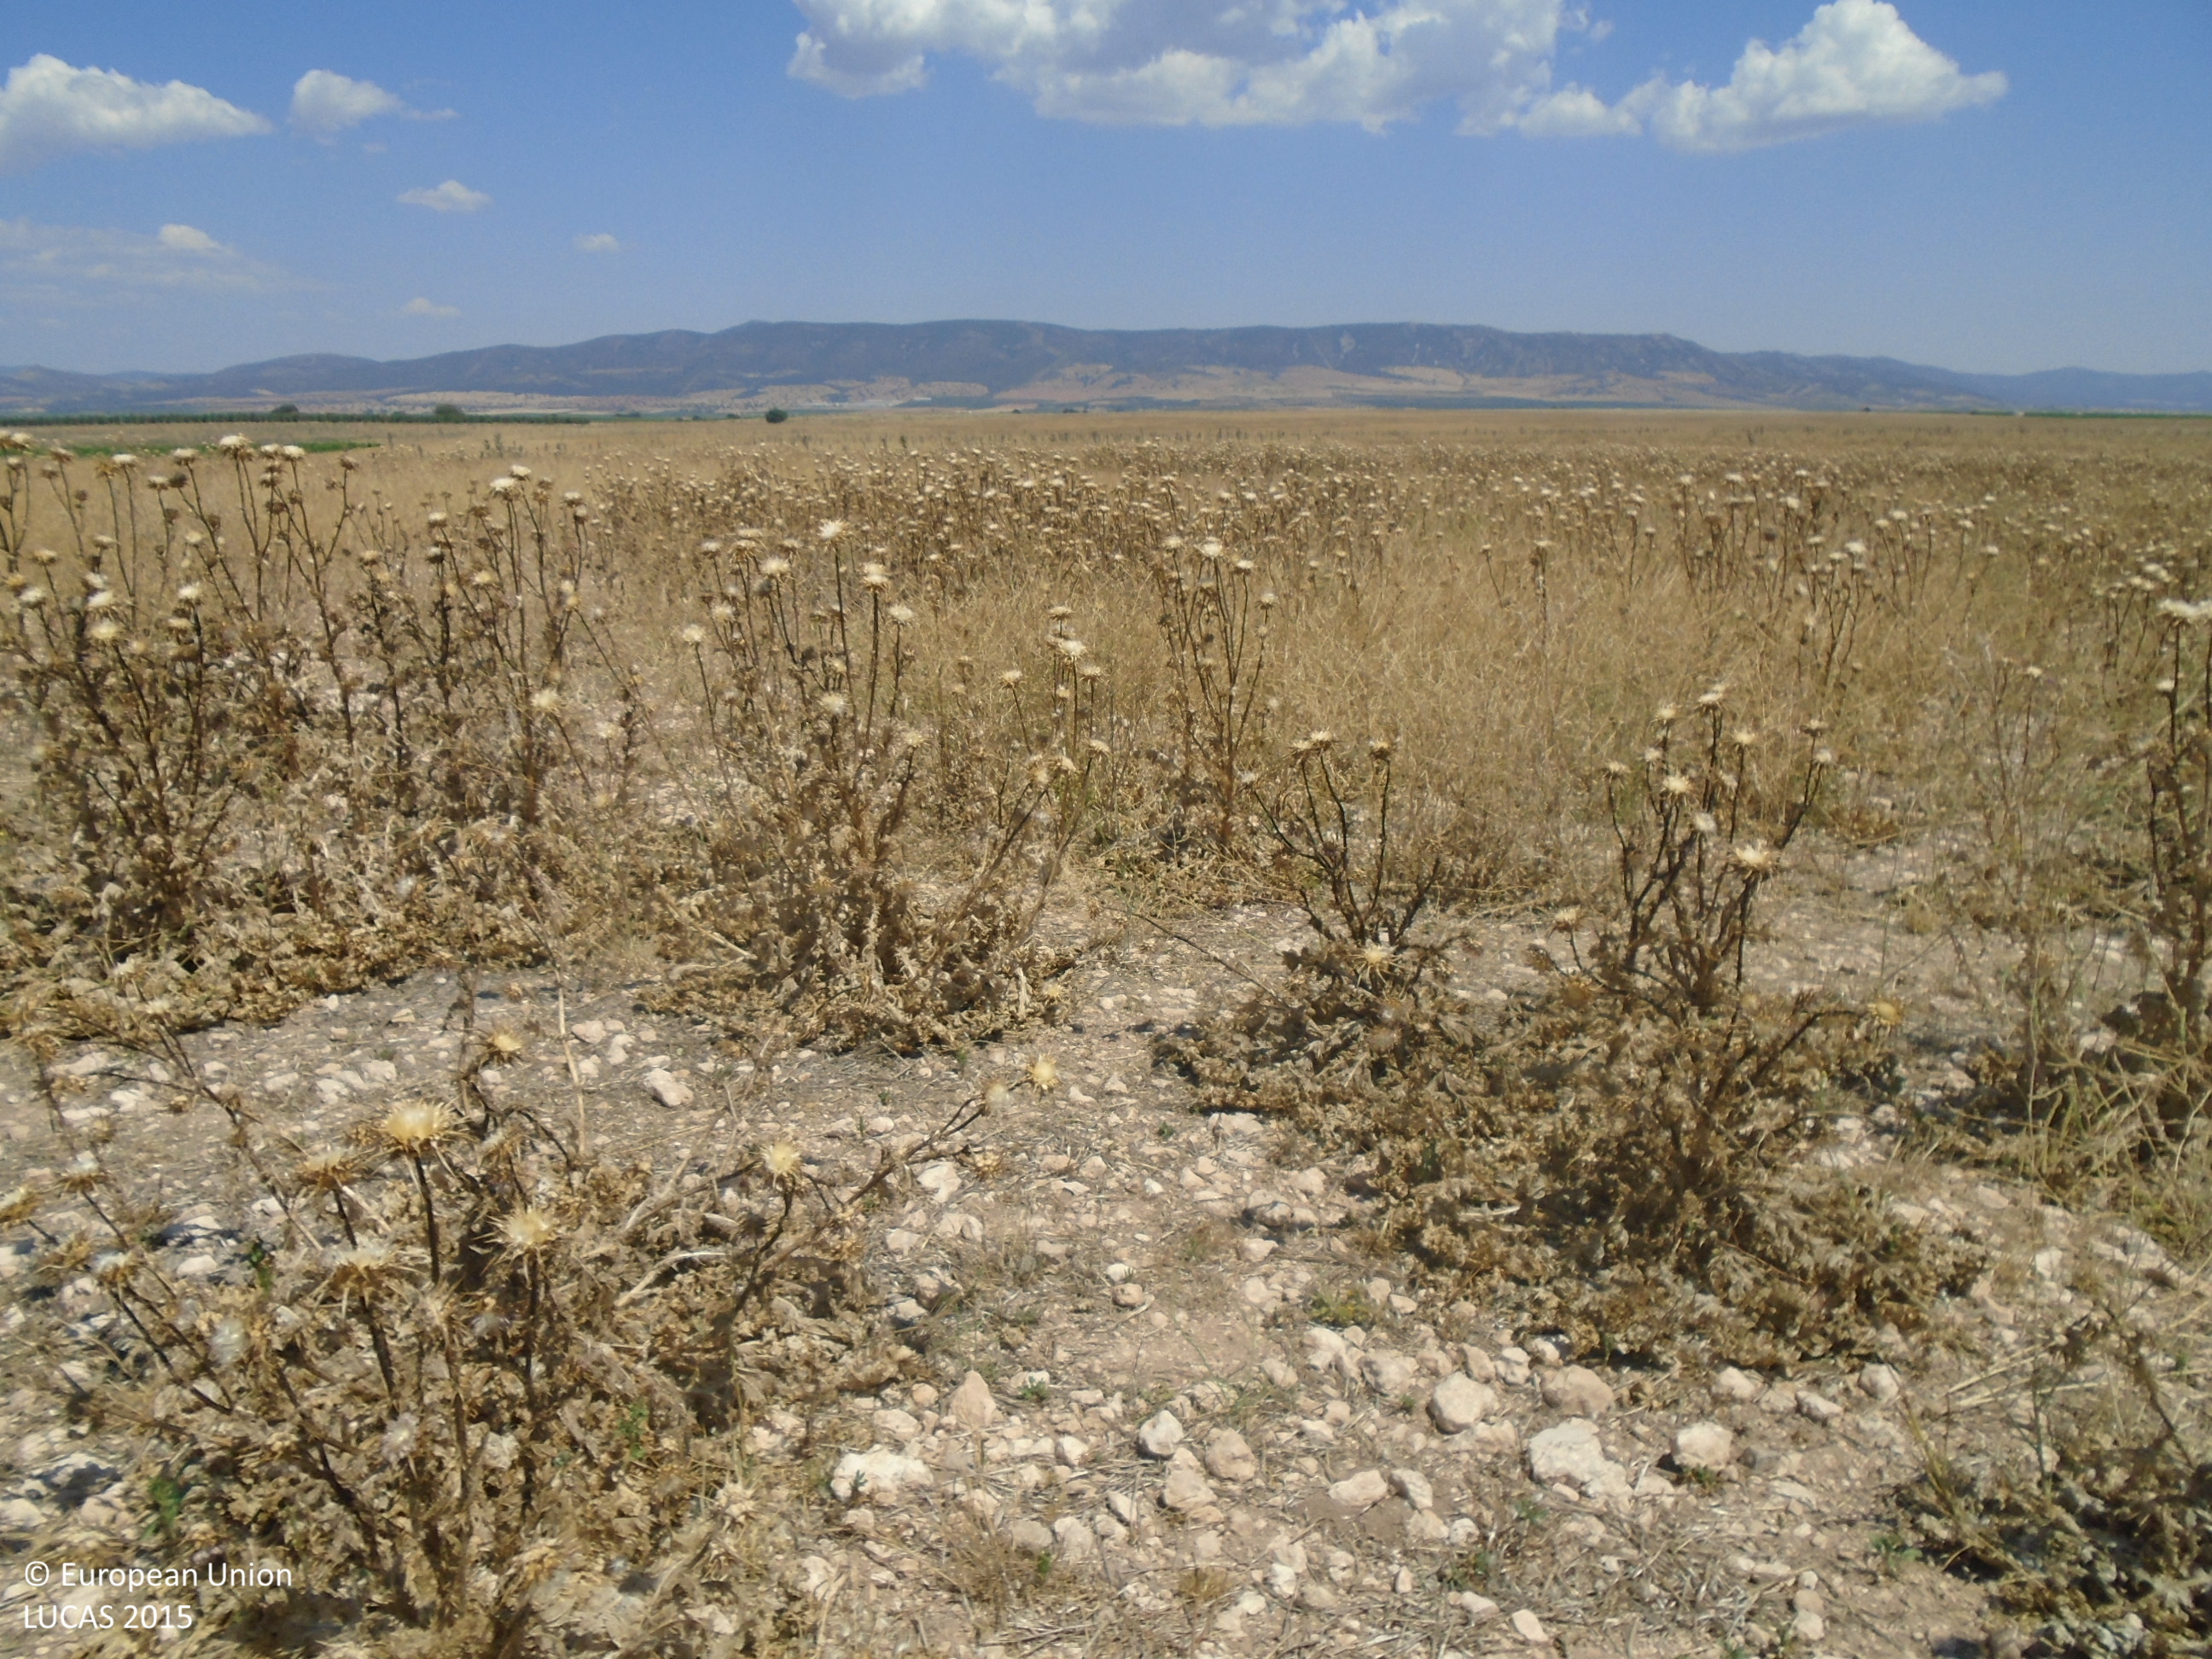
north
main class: Grassland
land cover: Spontaneously vegetated surfaces
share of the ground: > 75 %
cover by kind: herbaceous plants 90 %, consolidated bare surface 5 %, unconsolidated bare surface 5 %
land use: Fallow land
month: June
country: ES
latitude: 39.1420
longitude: -3.6604
